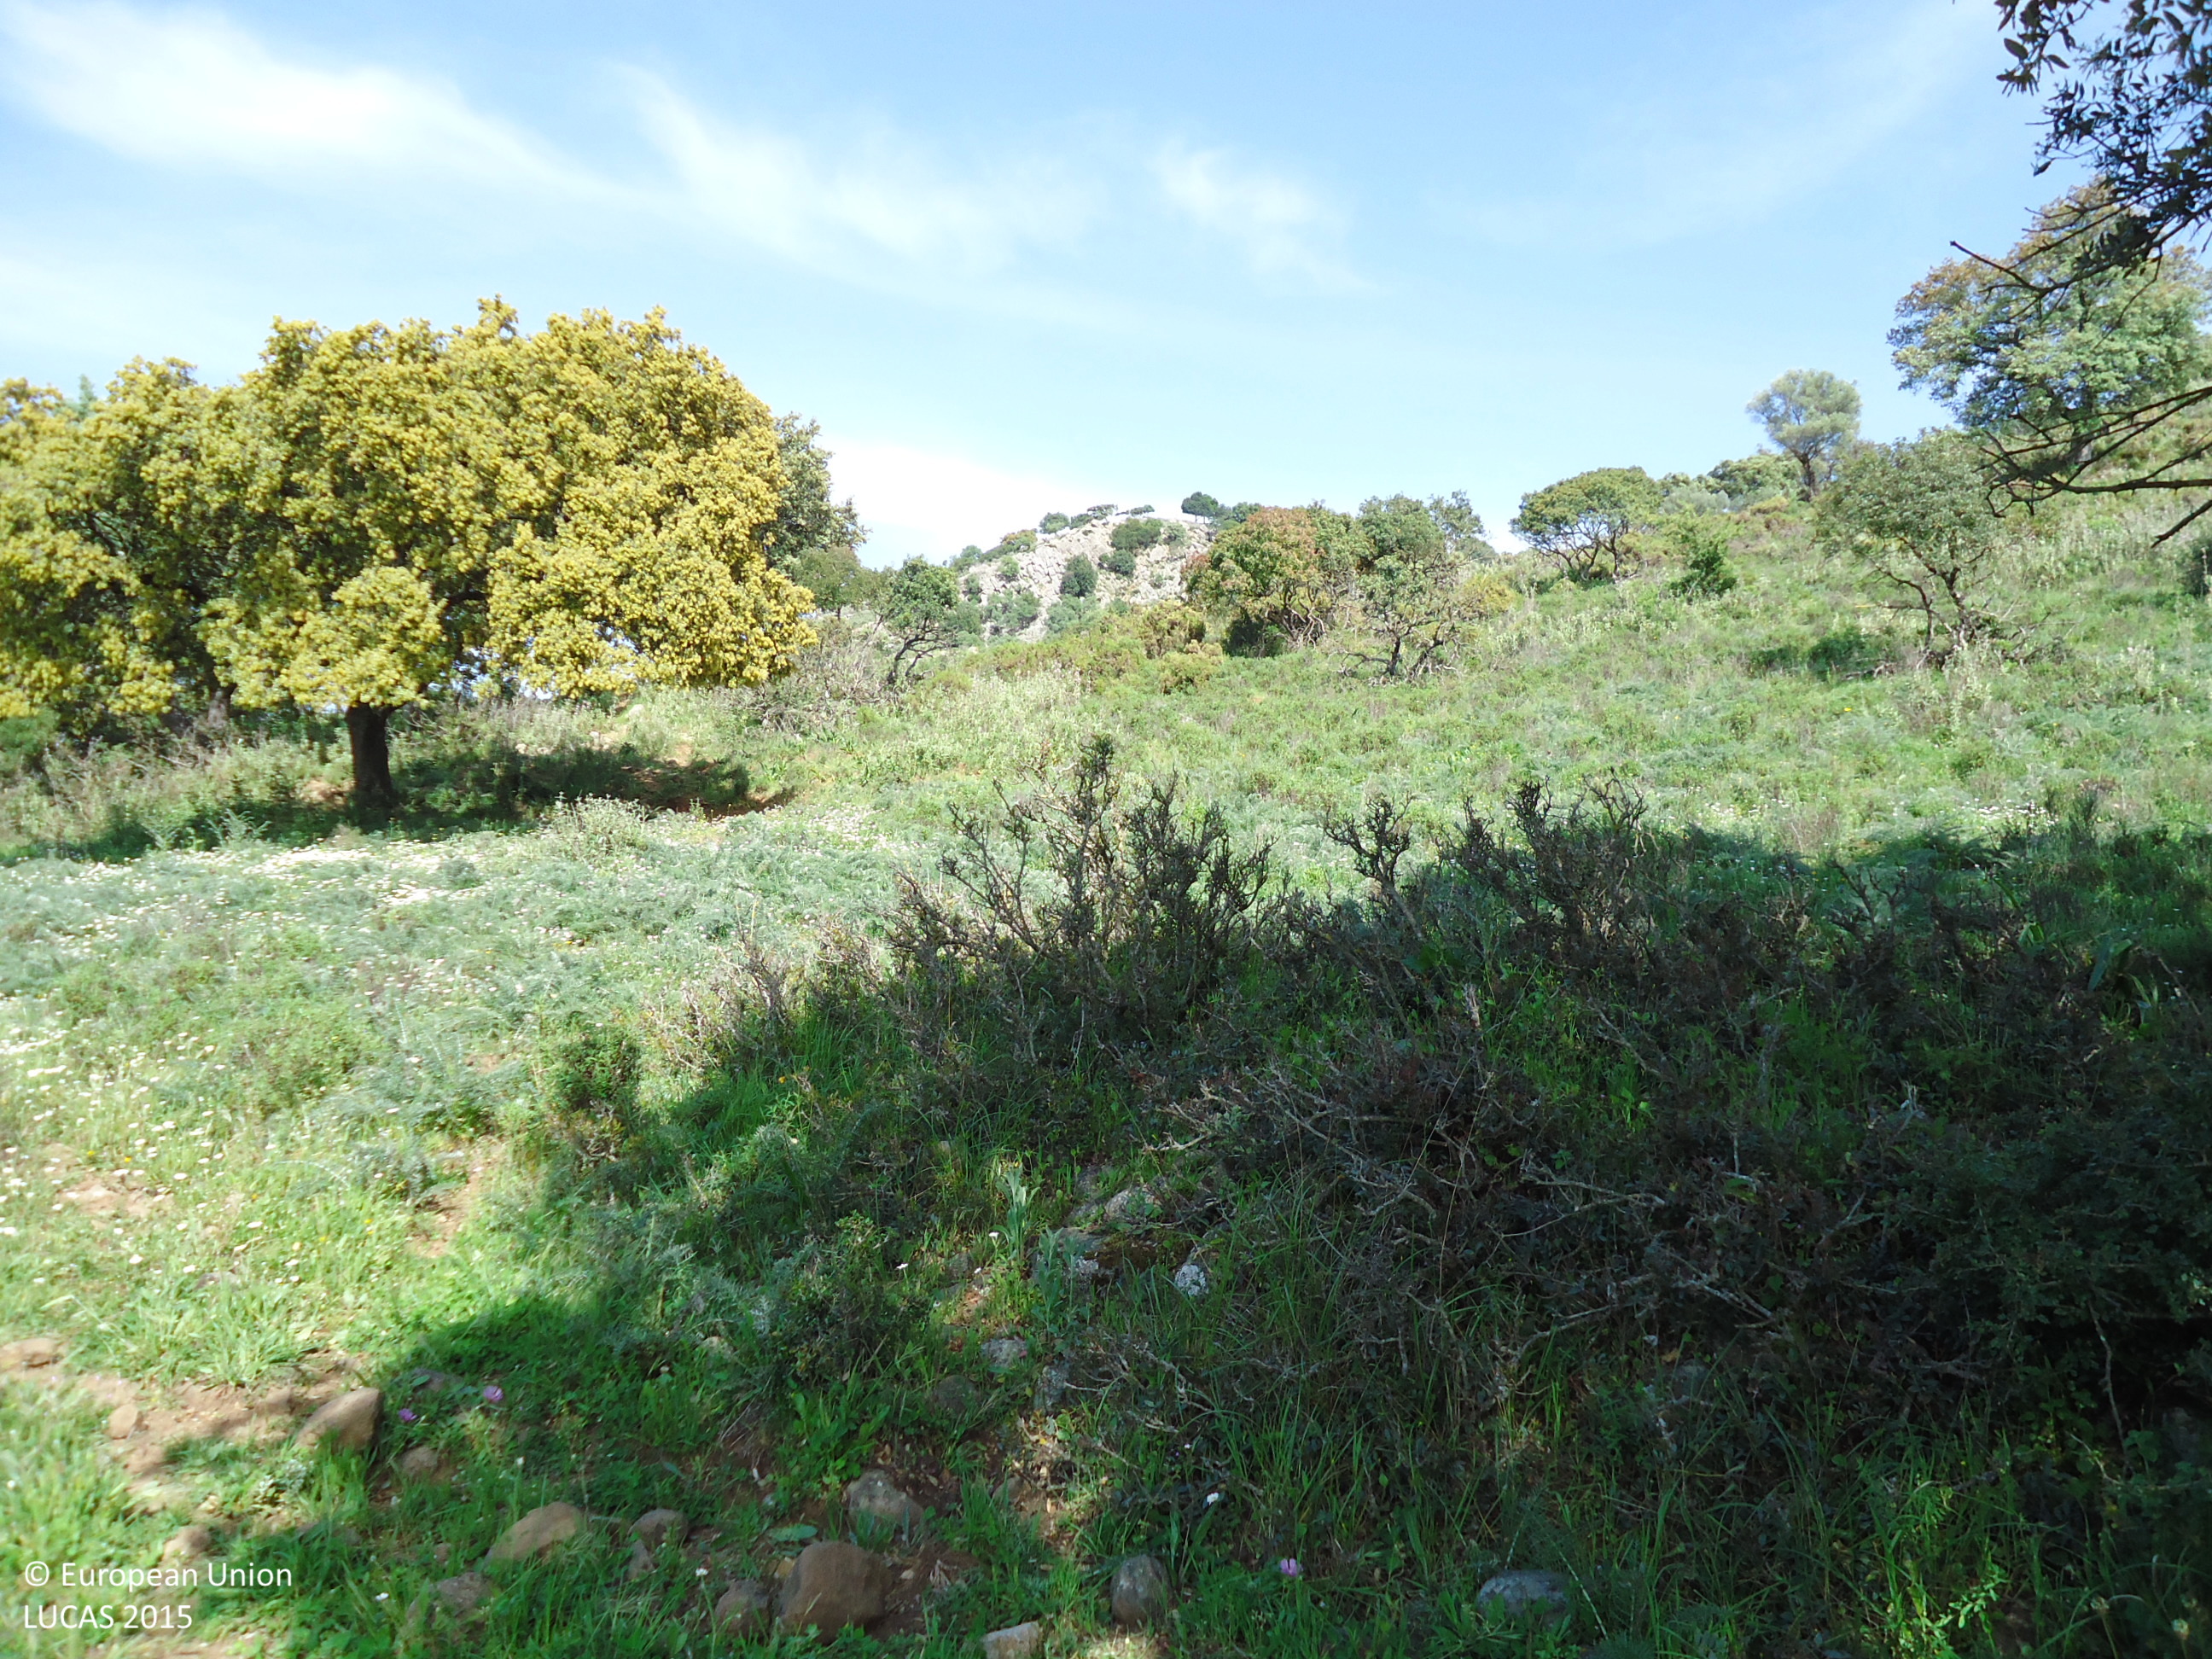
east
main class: Woodland
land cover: Broadleaved woodland
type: broadleaved evergreen forest
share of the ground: 25 - 50 %
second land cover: Spontaneously vegetated surfaces
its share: 50 - 75 %
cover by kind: herbaceous plants 55 %, broadleaved forest trees 30 %, shrubs 15 %
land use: Forestry
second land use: Agriculture (excluding fallow land and kitchen gardens)
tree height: > 5 m
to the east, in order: Broadleaved woodland; Spontaneously vegetated surfaces
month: April
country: ES
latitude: 36.9166
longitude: -5.4631
